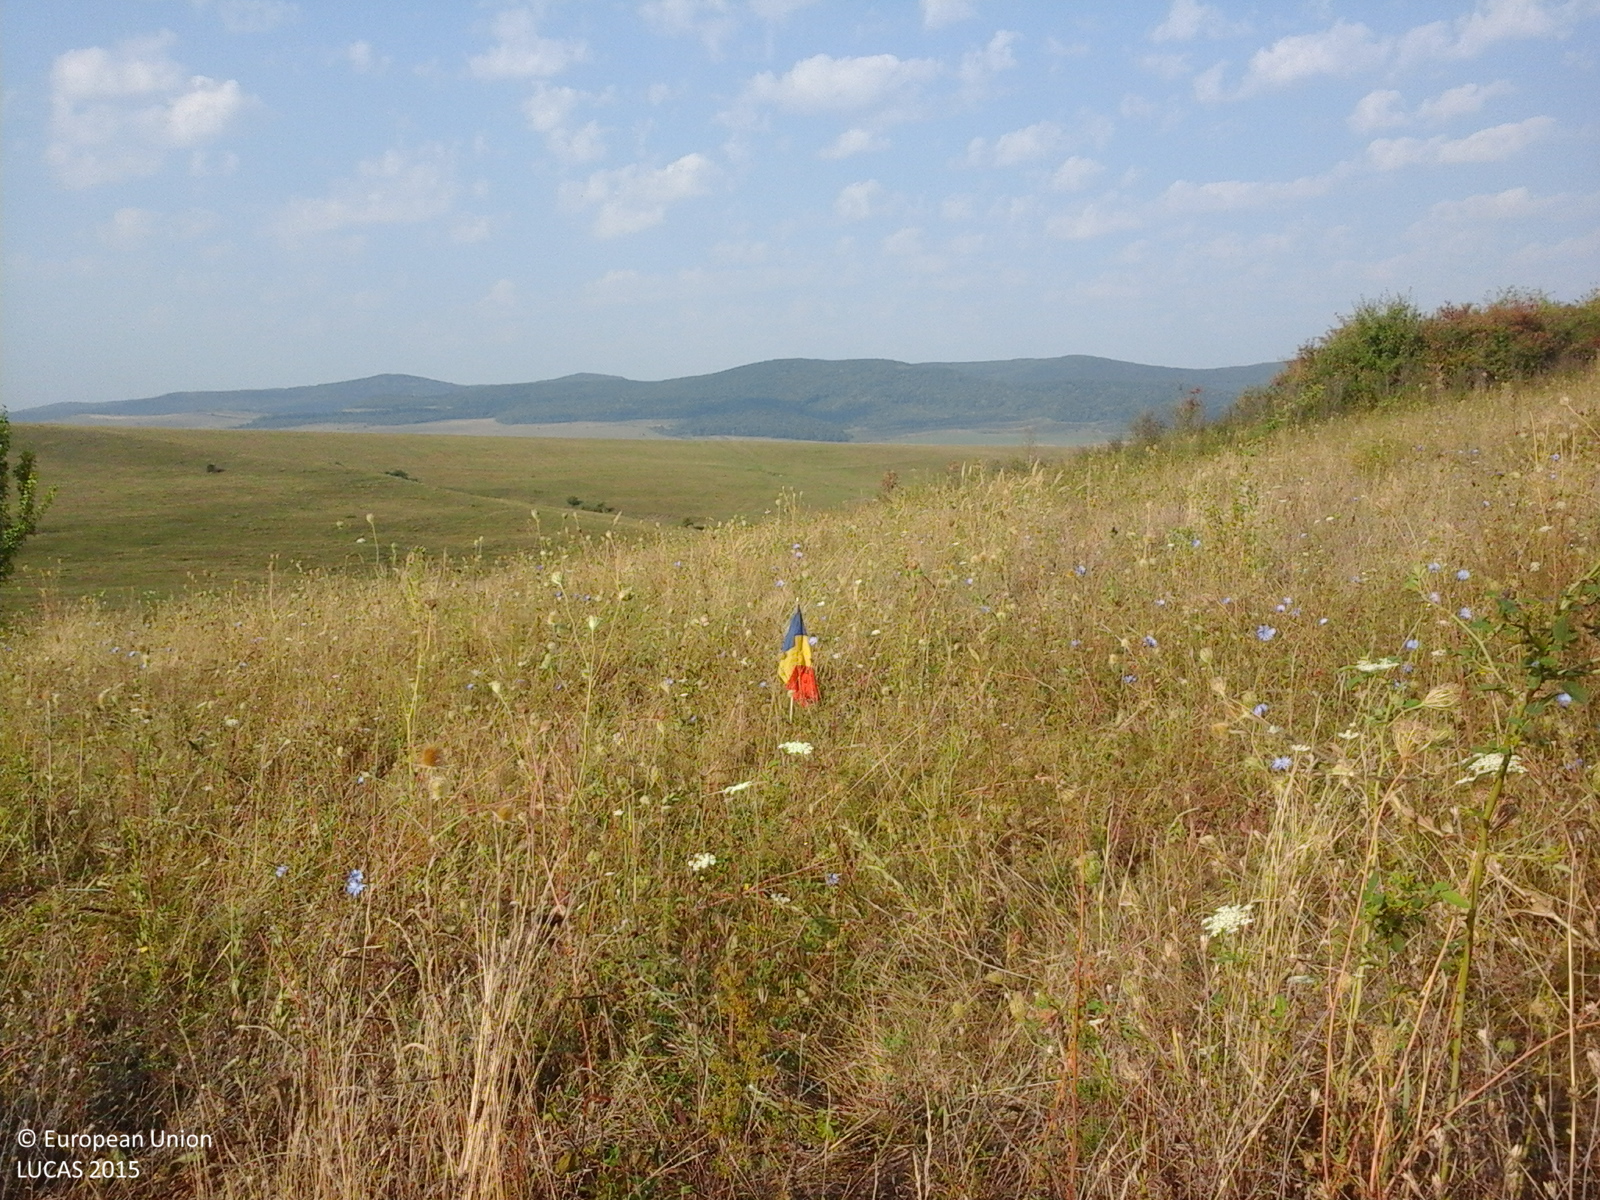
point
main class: Grassland
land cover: Grassland without tree/shrub cover
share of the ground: > 75 %
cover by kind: herbaceous plants 100 %
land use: Agriculture (excluding fallow land and kitchen gardens)
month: September
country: RO
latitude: 47.0388
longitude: 24.5014
